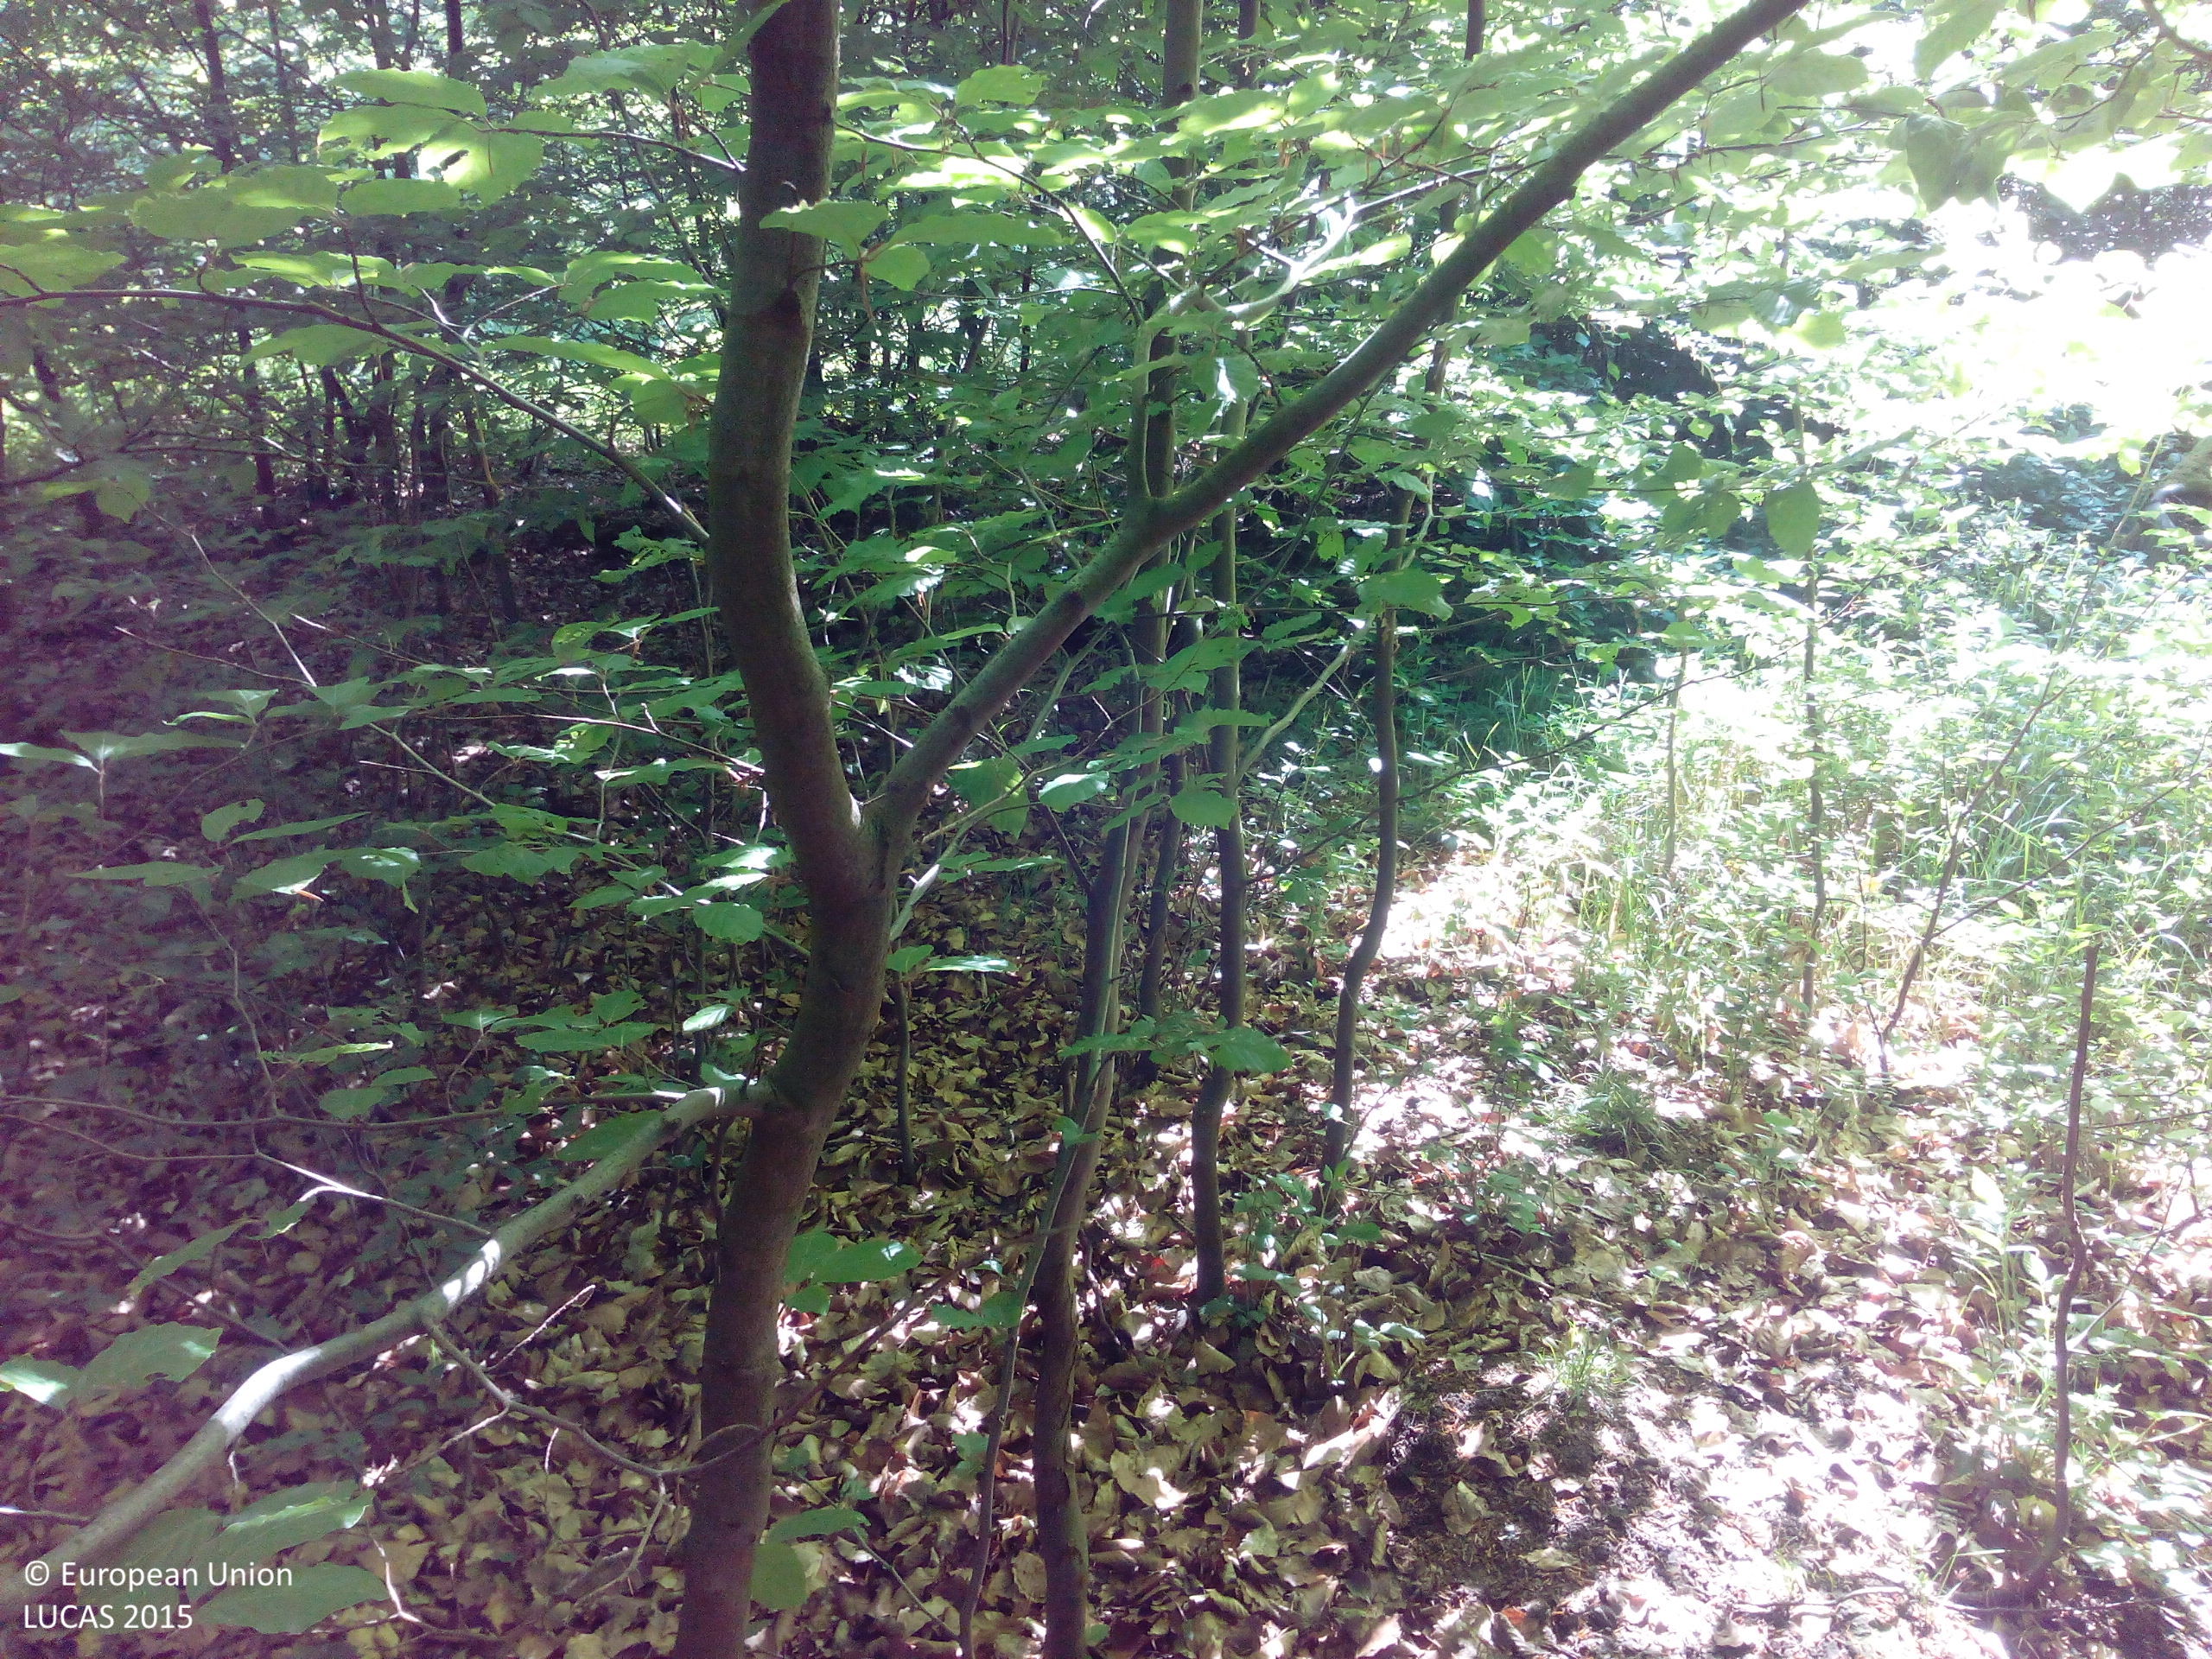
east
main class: Woodland
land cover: Broadleaved woodland
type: mesophytic deciduous forest
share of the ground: > 75 %
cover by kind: broadleaved forest trees 85 %, unconsolidated bare surface 15 %
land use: Forestry
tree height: > 5 m
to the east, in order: Broadleaved woodland; Ditches and canals; Other mixed woodland; Tracks; Pine dominated mixed woodland
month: May
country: DE
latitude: 49.9407
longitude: 8.5095
